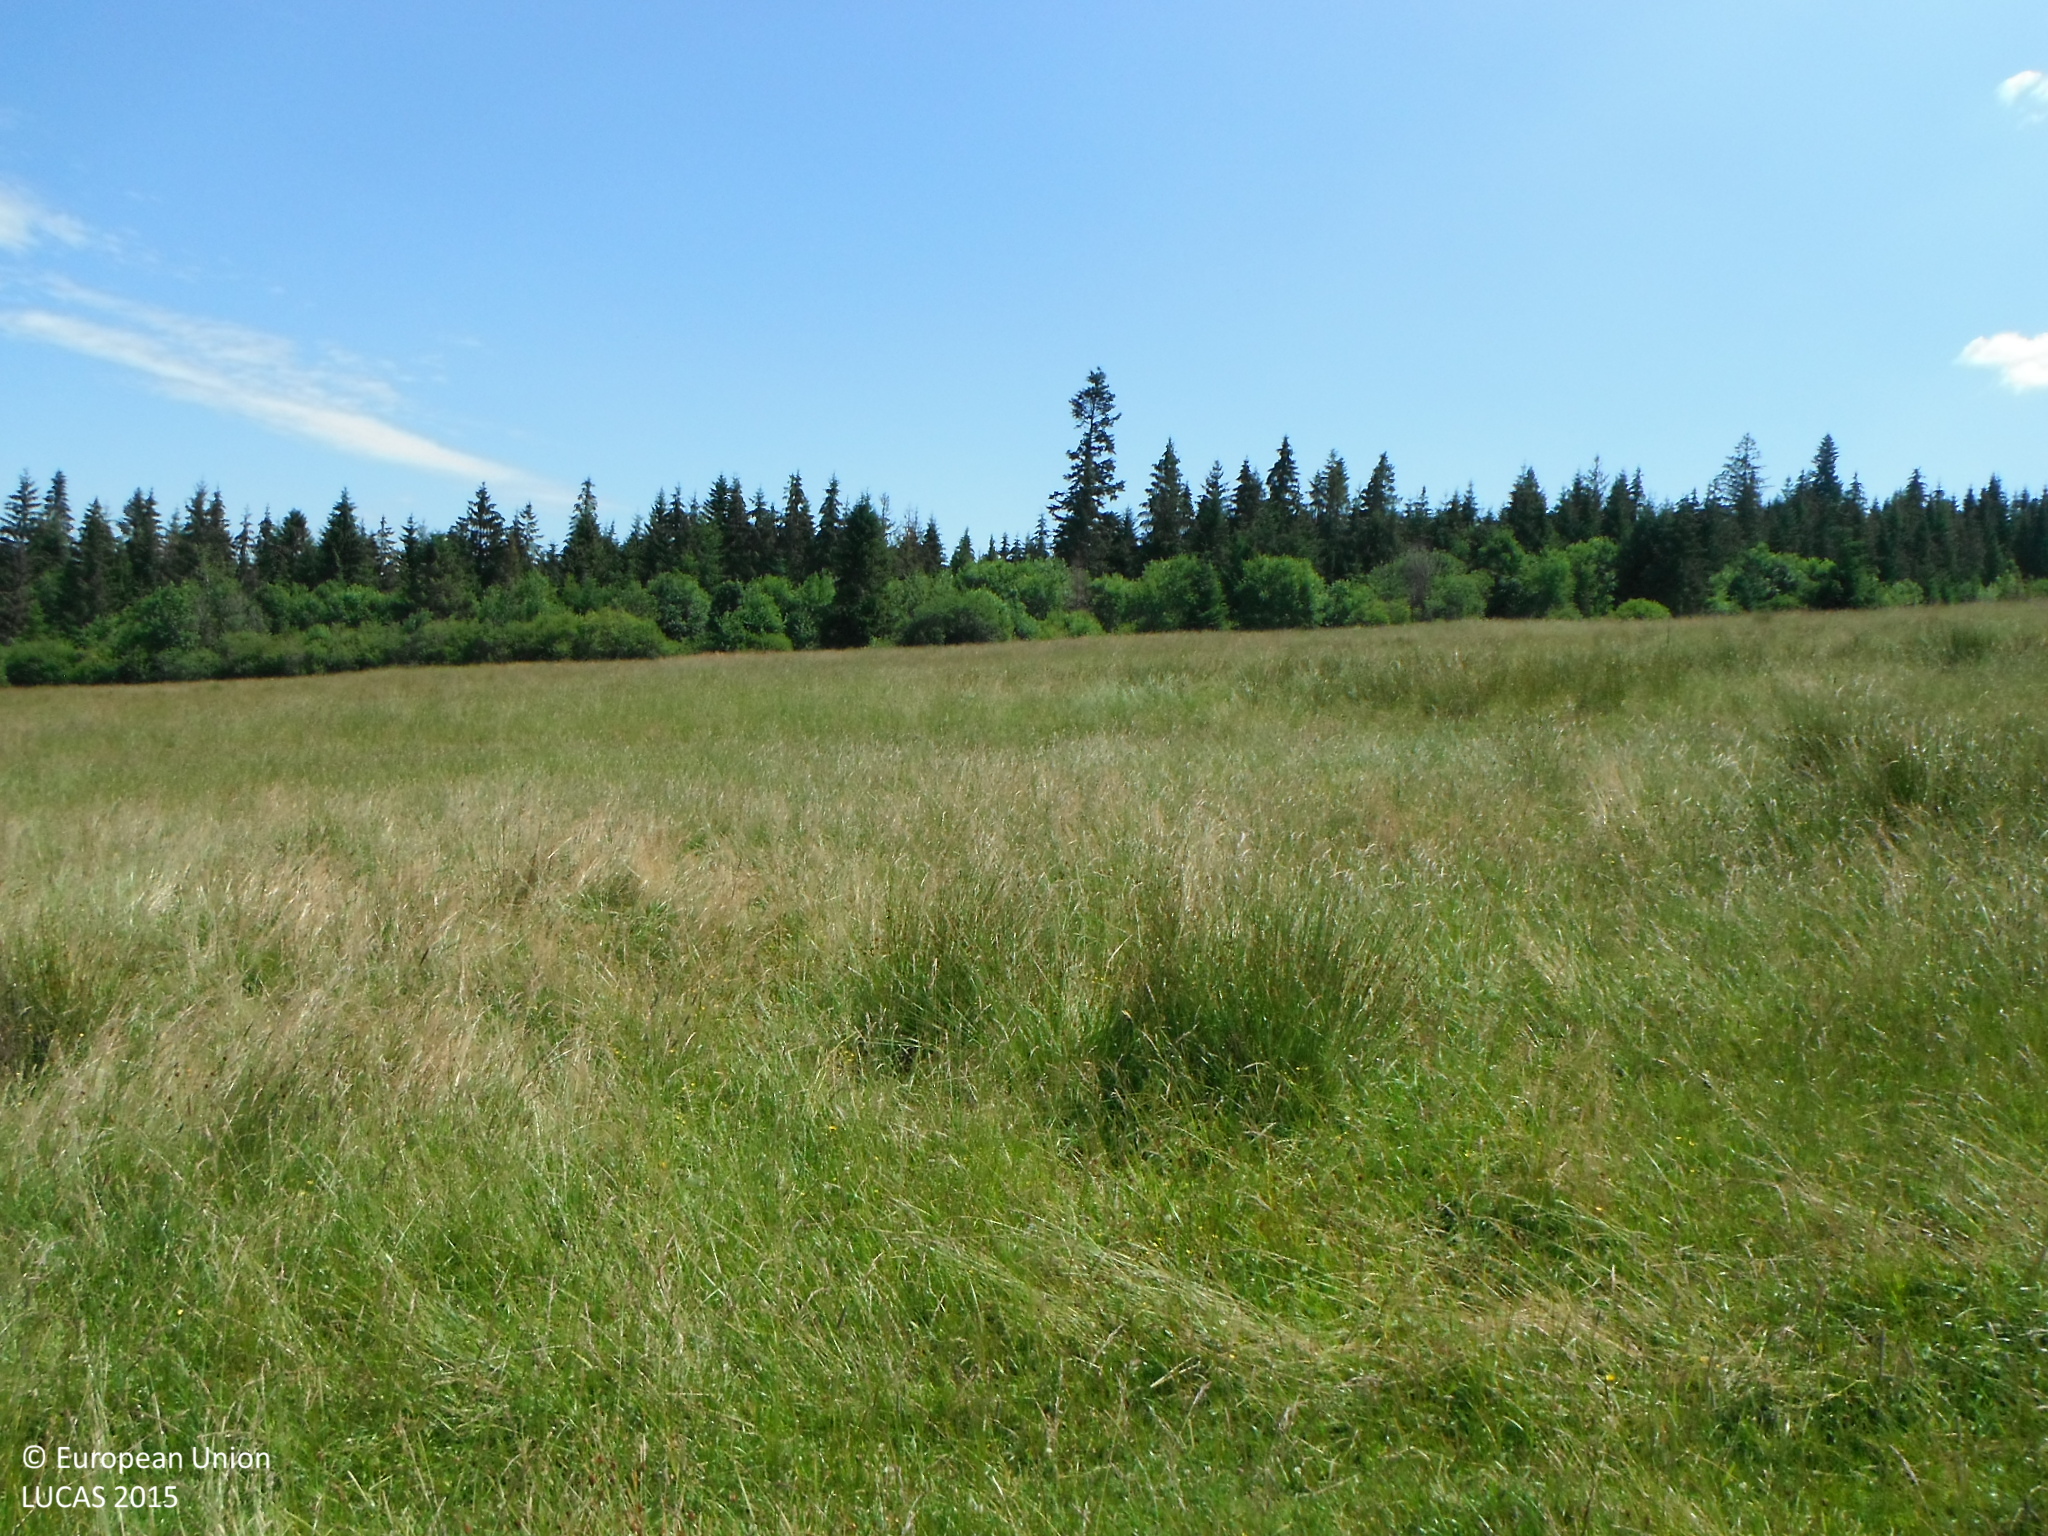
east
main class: Grassland
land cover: Grassland without tree/shrub cover
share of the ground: > 75 %
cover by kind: herbaceous plants 100 %
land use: Agriculture (excluding fallow land and kitchen gardens)
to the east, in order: Grassland without tree/shrub cover; Tracks; Grassland without tree/shrub cover; Tracks; Grassland without tree/shrub cover; Tracks; Spruce dominated mixed woodland; Ditches and canals; Spruce dominated mixed woodland; Tracks; Spruce dominated coniferous woodland; Spruce dominated mixed woodland; Spruce dominated coniferous woodland
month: July
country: SK
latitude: 49.3300
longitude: 19.7573
